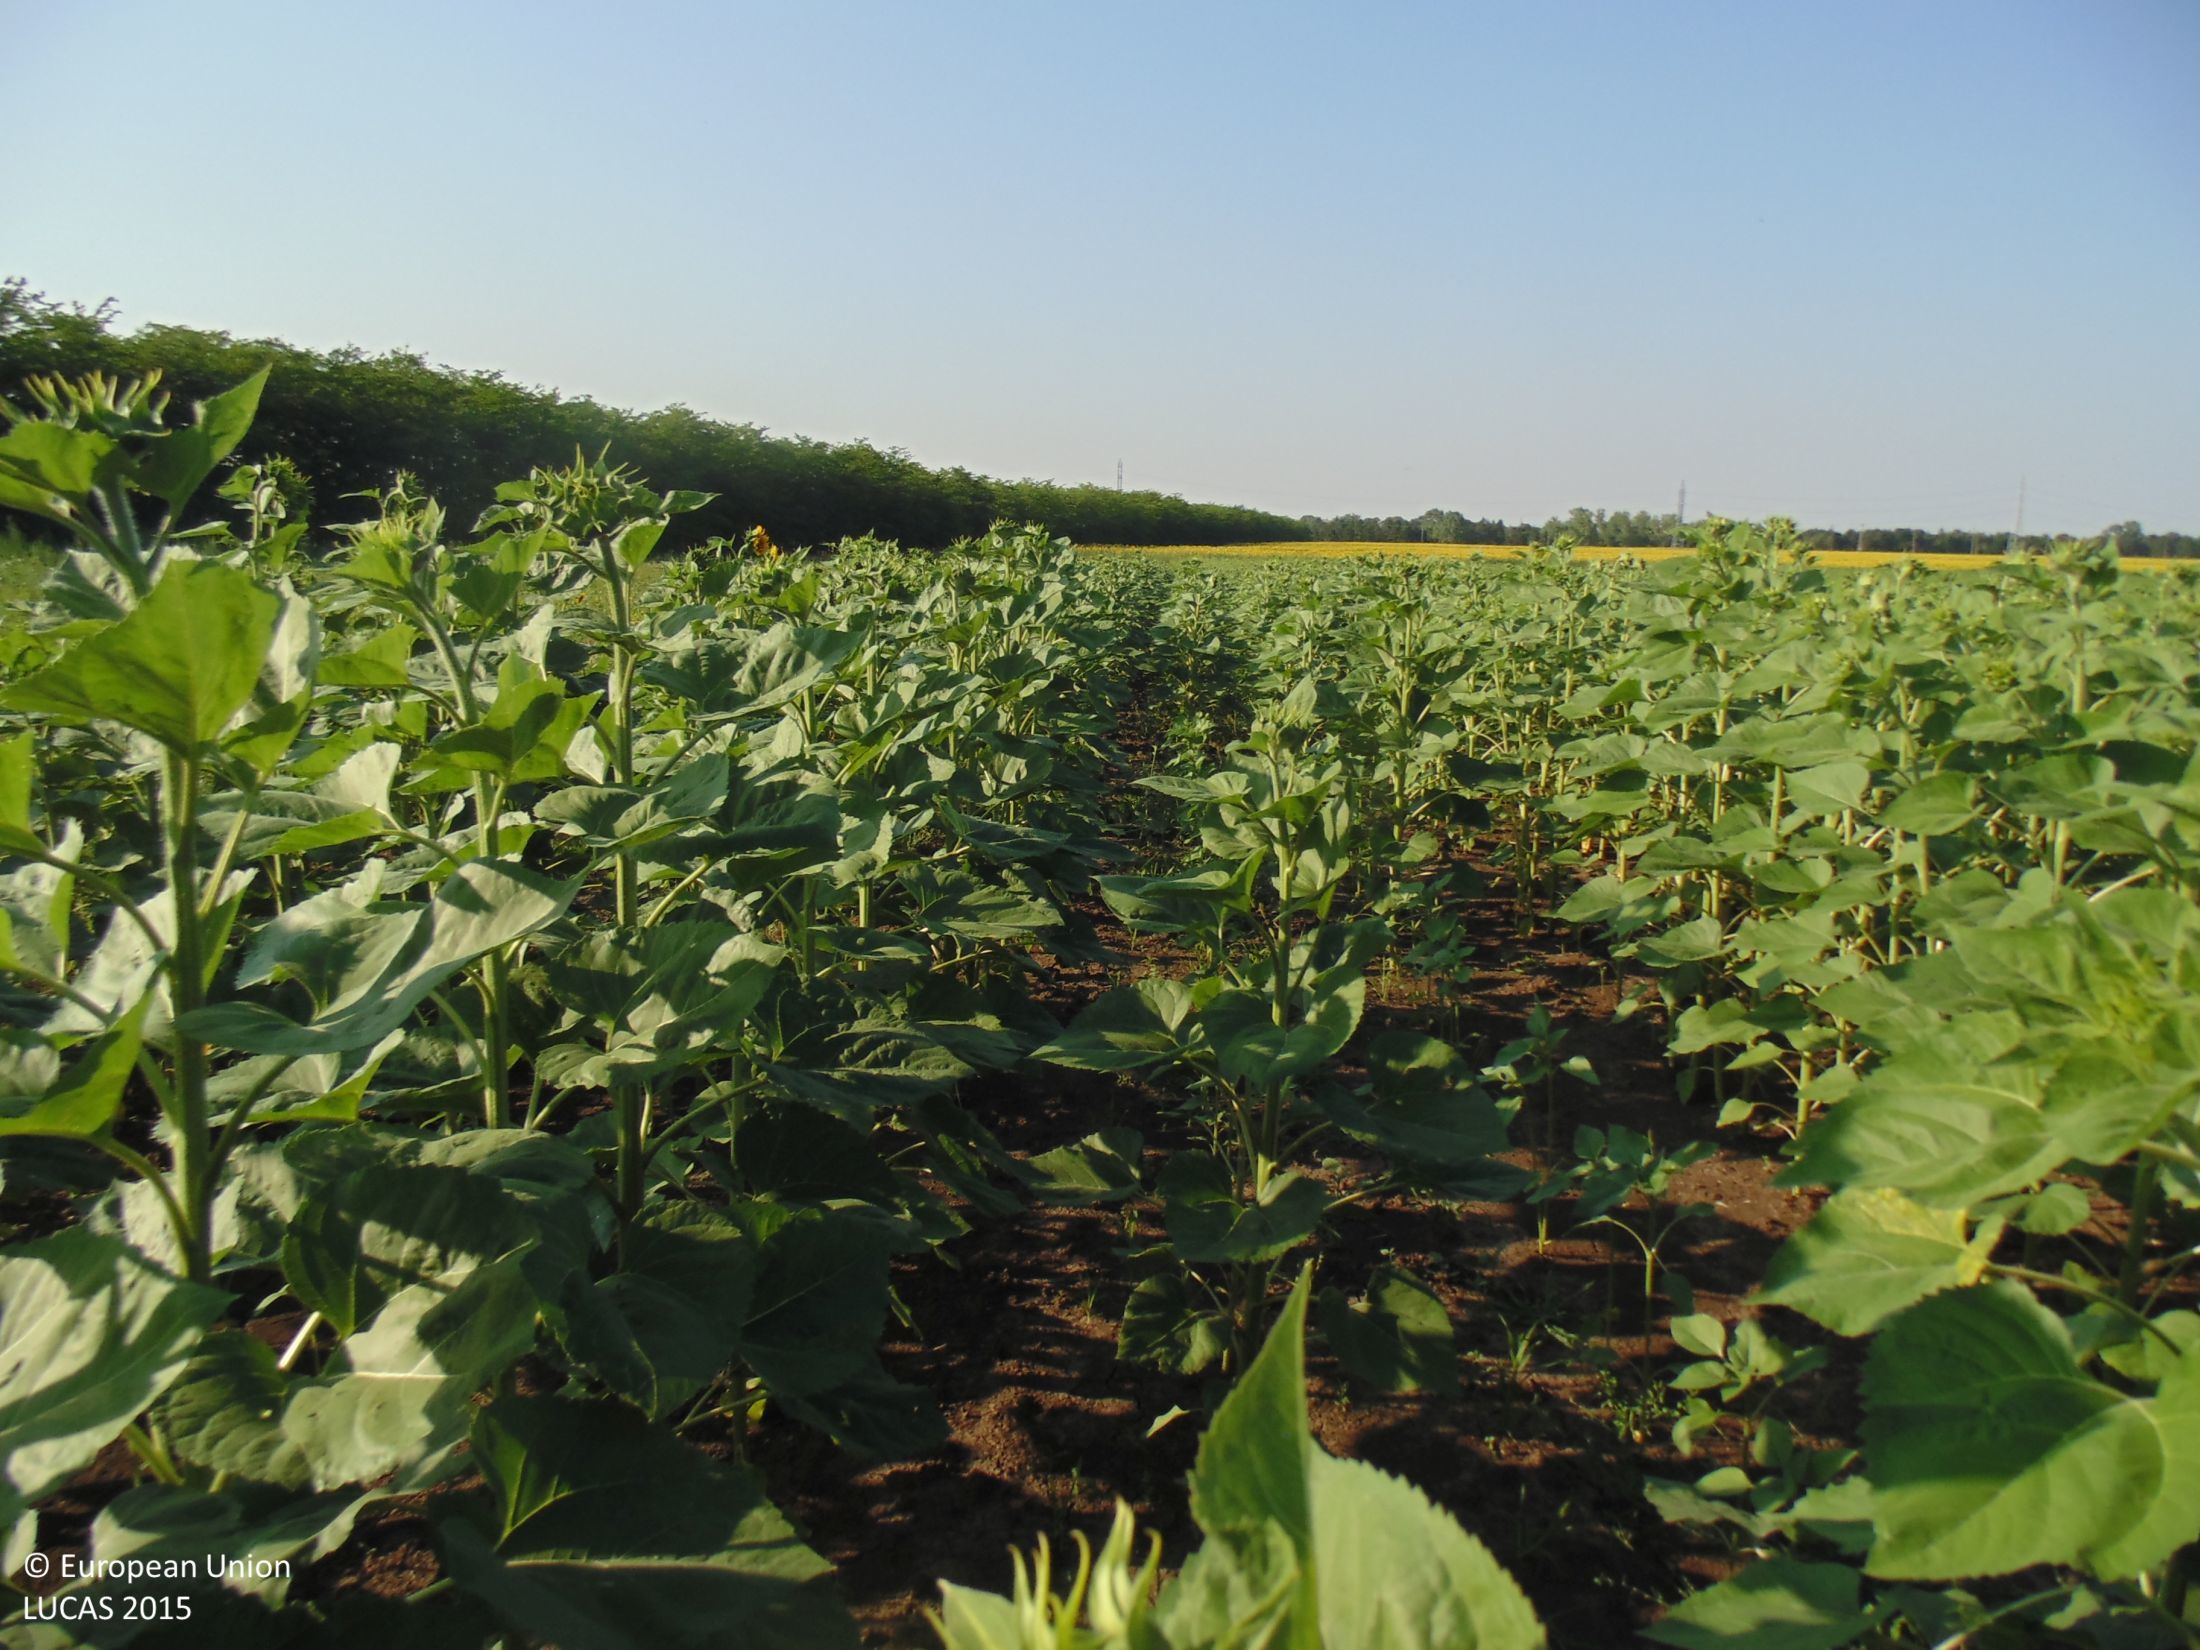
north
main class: Cropland
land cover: Sunflower
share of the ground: > 75 %
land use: Agriculture (excluding fallow land and kitchen gardens)
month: July
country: BG
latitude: 43.5130
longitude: 28.0212
